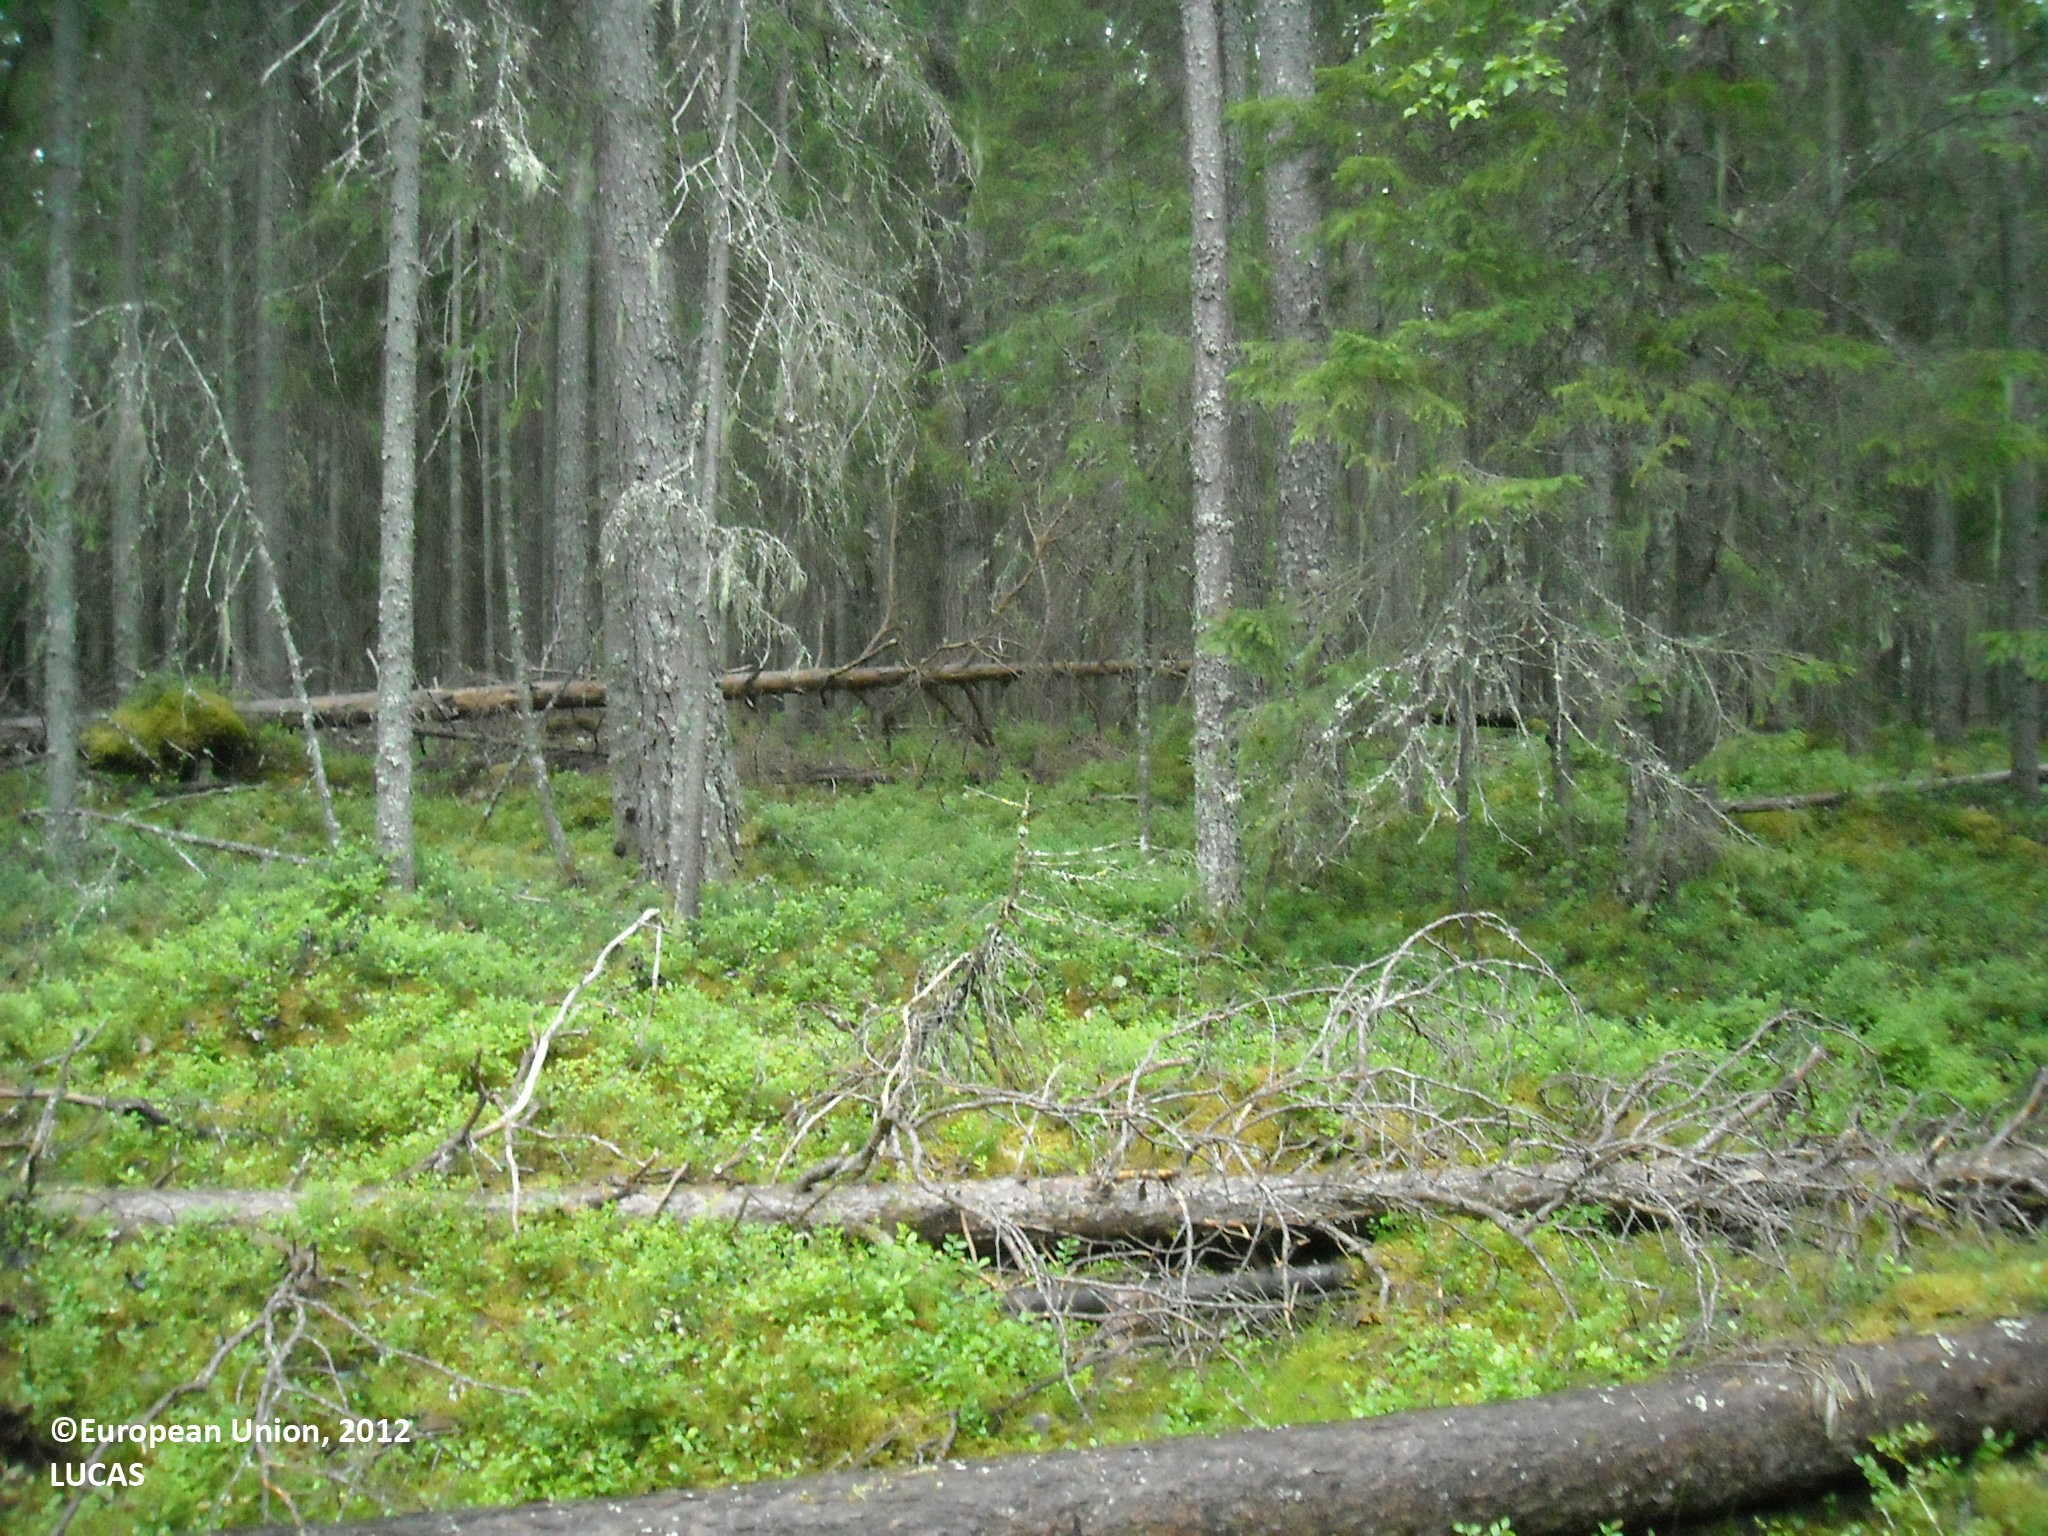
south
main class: Woodland
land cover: Other coniferous woodland
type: boreal forest
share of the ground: > 75 %
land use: Semi-natural and natural areas not in use
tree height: > 5 m
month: July
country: FI
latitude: 65.0223
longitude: 26.7326
